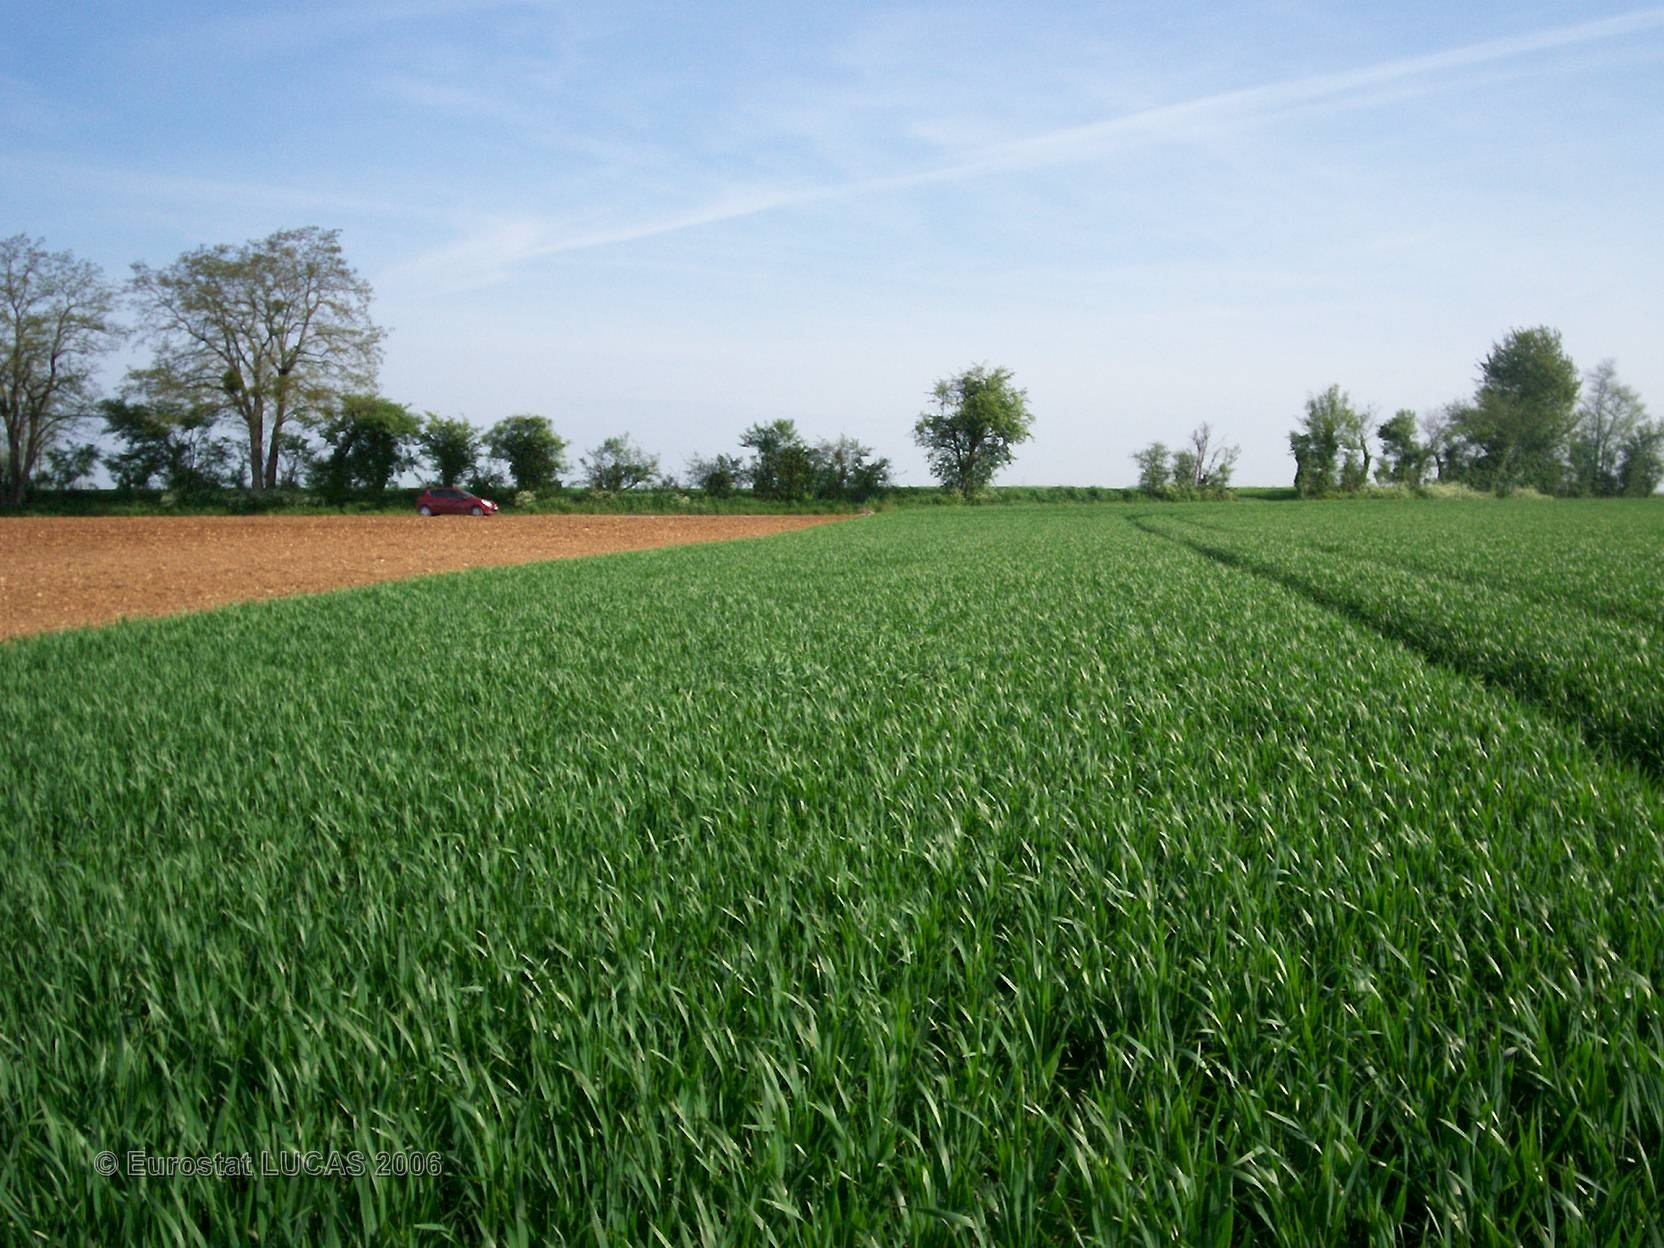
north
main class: Cropland
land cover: Common wheat
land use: Agriculture (excluding fallow land and kitchen gardens)
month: May
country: FR
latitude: 46.2382
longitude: -0.2548
